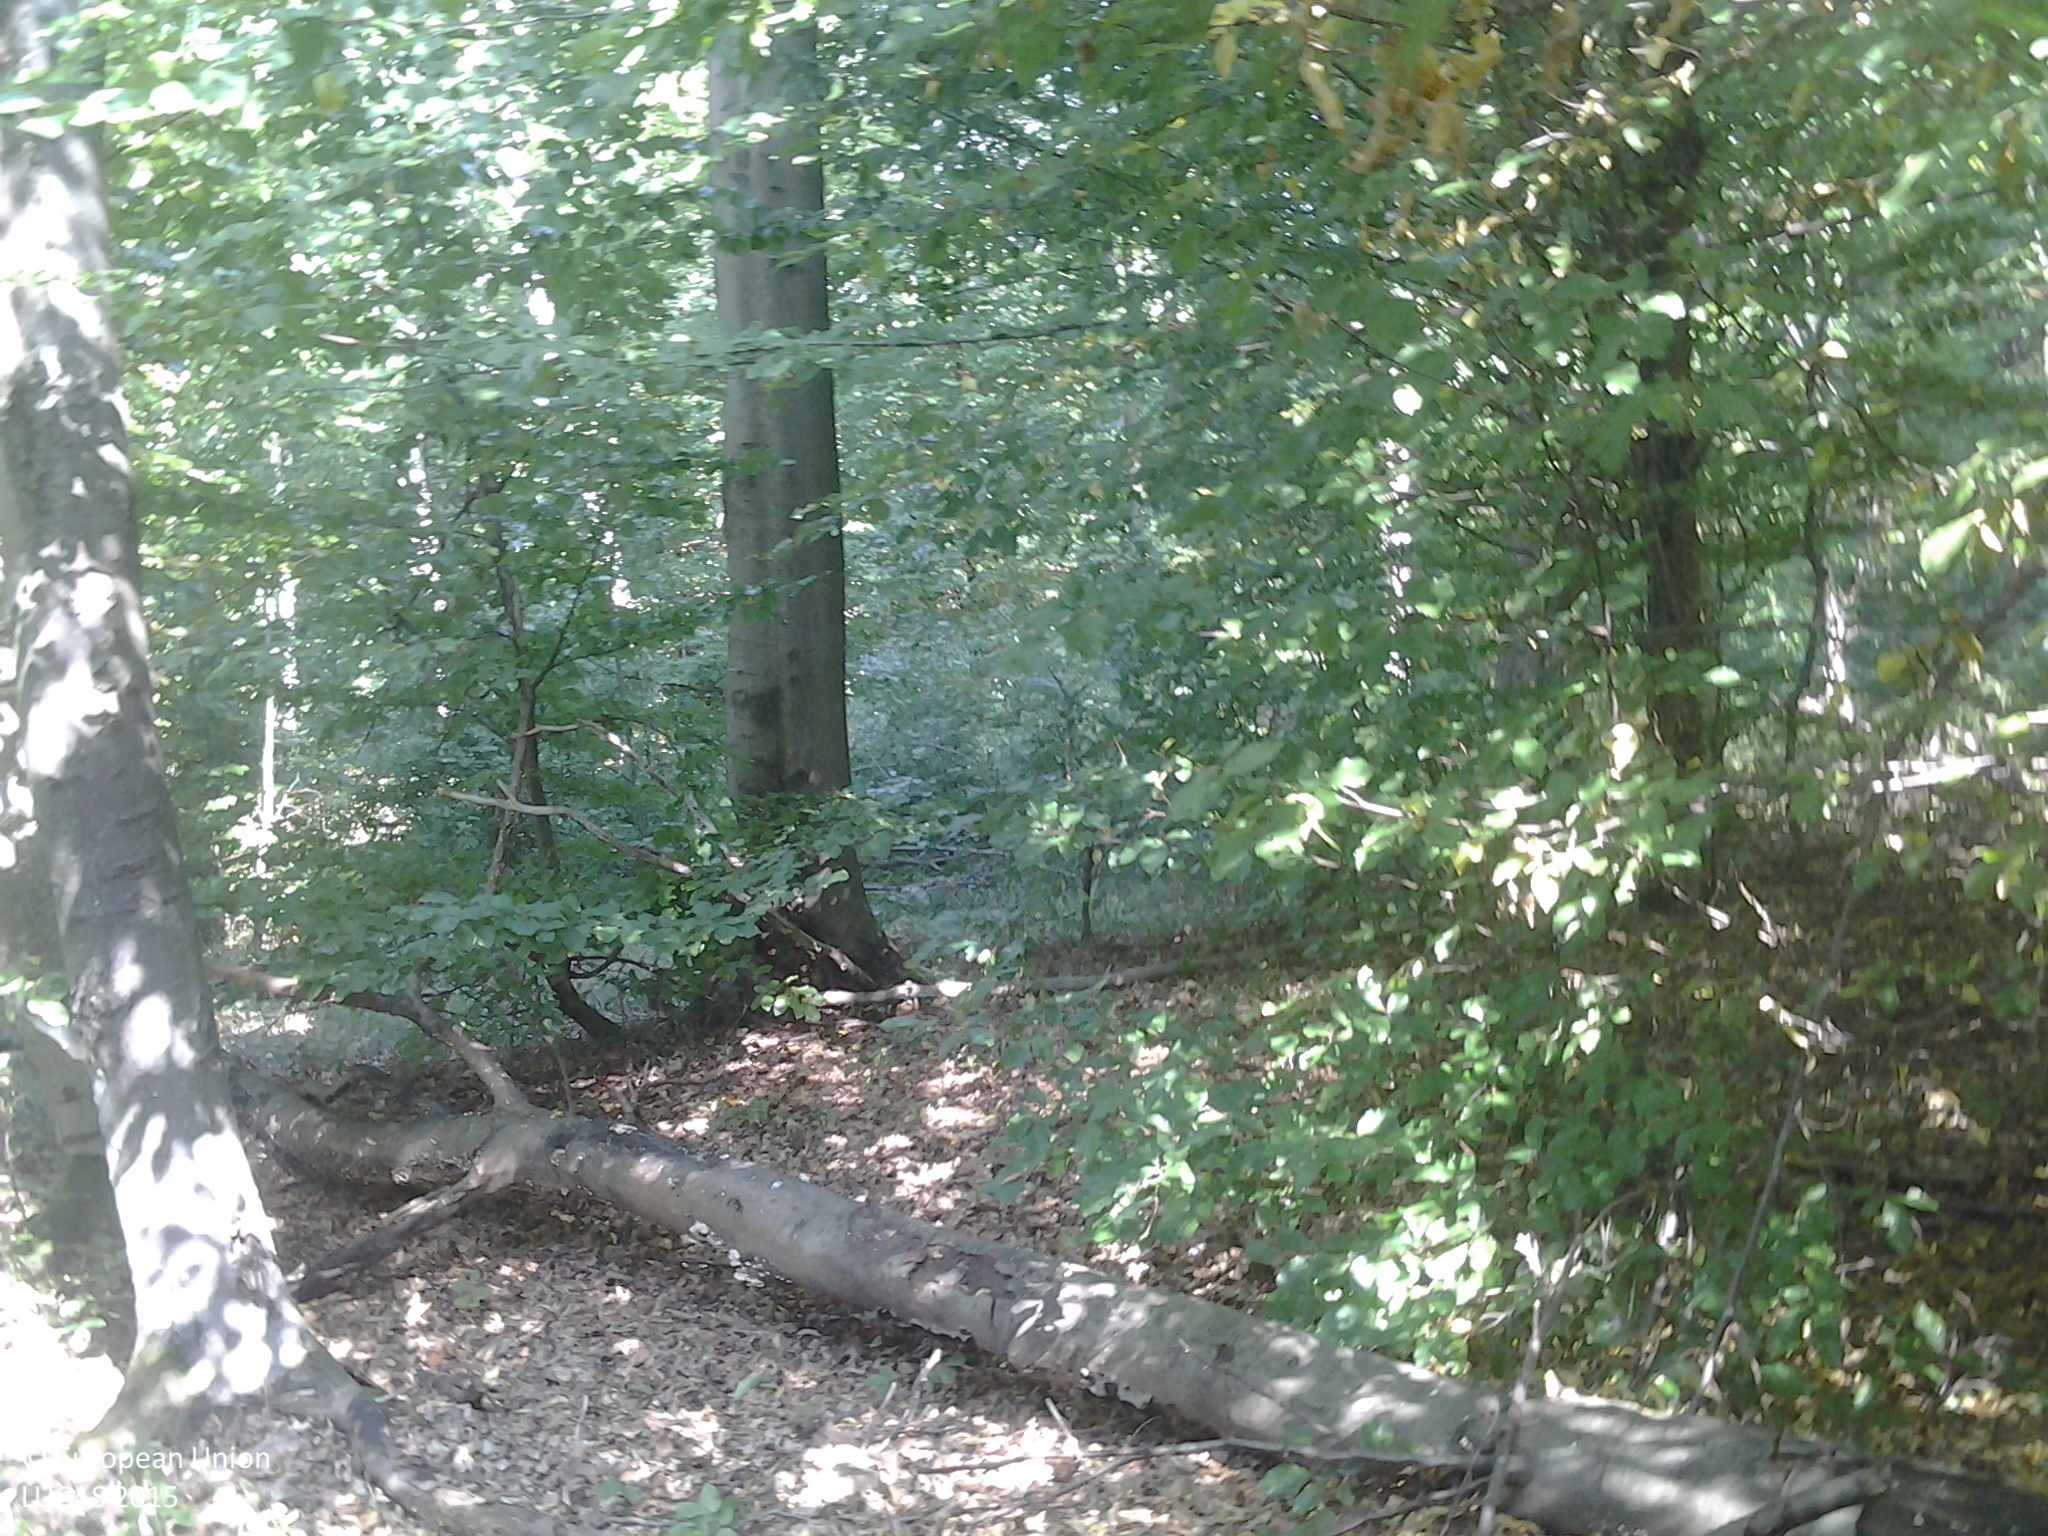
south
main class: Woodland
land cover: Broadleaved woodland
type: beech forest
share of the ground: > 75 %
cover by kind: broadleaved forest trees 85 %, shrubs 15 %
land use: Forestry
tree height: > 5 m
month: August
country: HU
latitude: 47.9382
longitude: 19.9197
